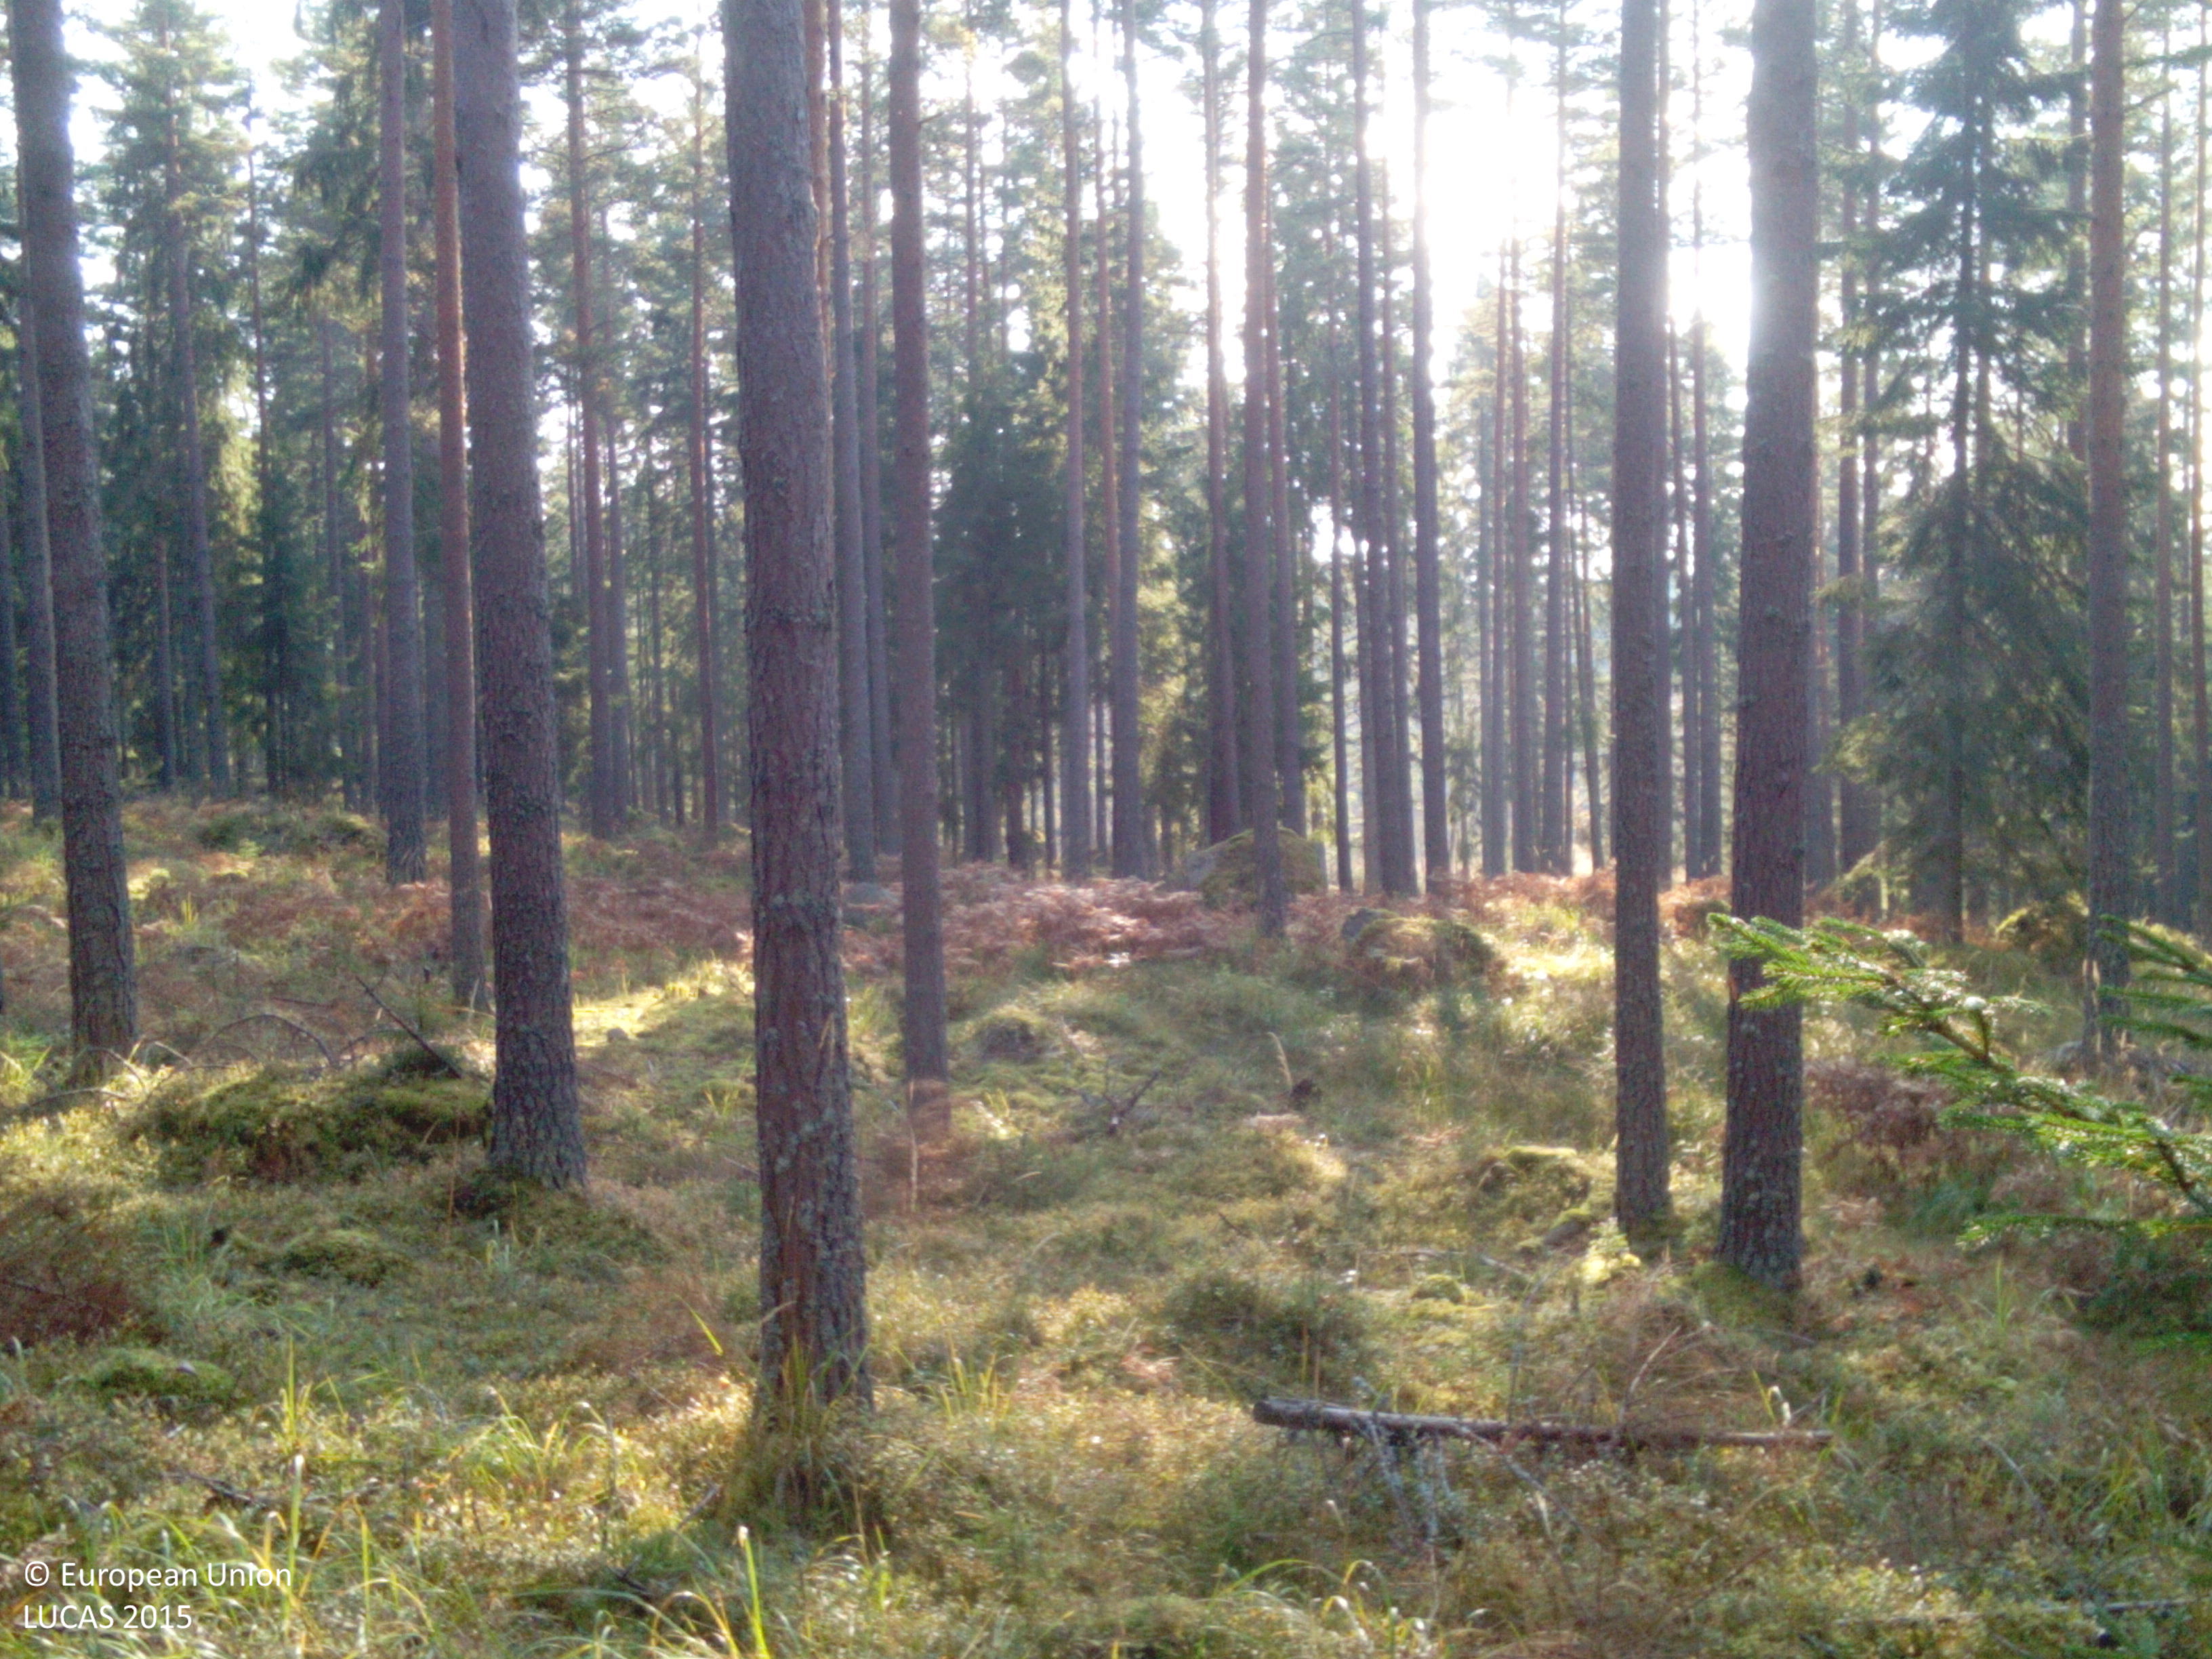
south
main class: Woodland
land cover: Other coniferous woodland
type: boreal forest
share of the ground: > 75 %
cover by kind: coniferous forest trees 85 %, herbaceous plants 10 %, lichens and mosses 5 %
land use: Forestry
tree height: > 5 m
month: October
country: SE
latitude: 58.8877
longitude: 16.2231
